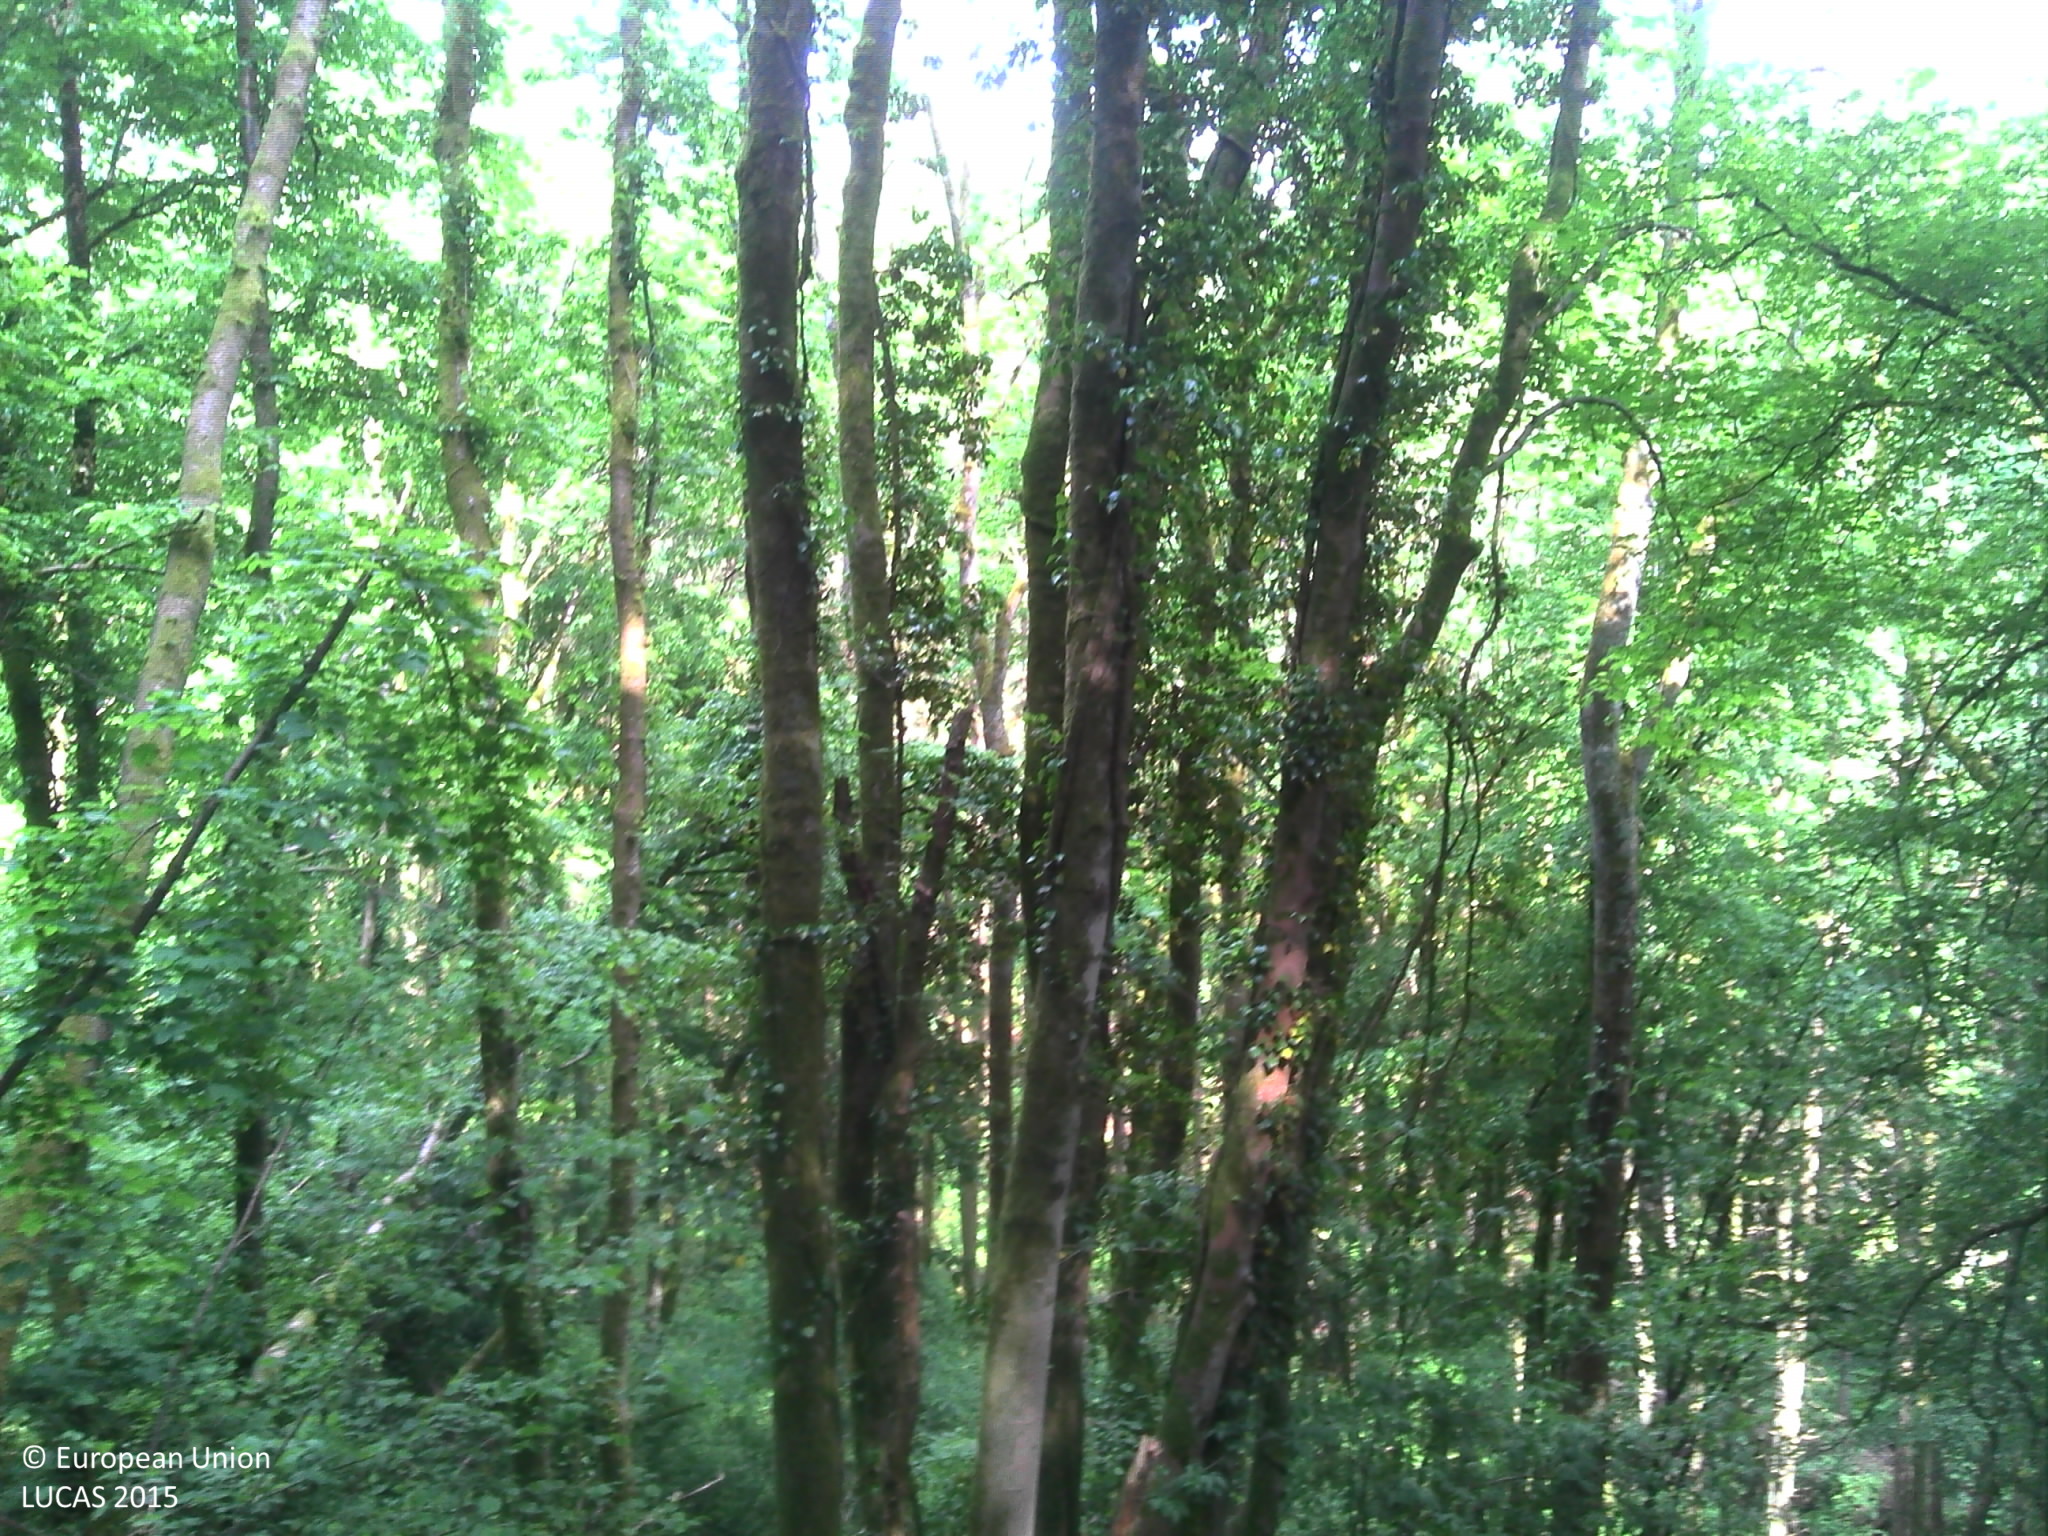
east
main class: Woodland
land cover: Broadleaved woodland
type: acidophilous oak and oak-birch forest
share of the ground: > 75 %
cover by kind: broadleaved forest trees 95 %, herbaceous plants 5 %
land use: Forestry
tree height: > 5 m
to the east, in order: Broadleaved woodland; Tracks; Other coniferous woodland; Rivers and streams; Other coniferous woodland; Shrubland without tree cover; Broadleaved woodland; Spontaneously vegetated surfaces; Shrubland without tree cover
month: June
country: BE
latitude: 49.8895
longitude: 4.8888
